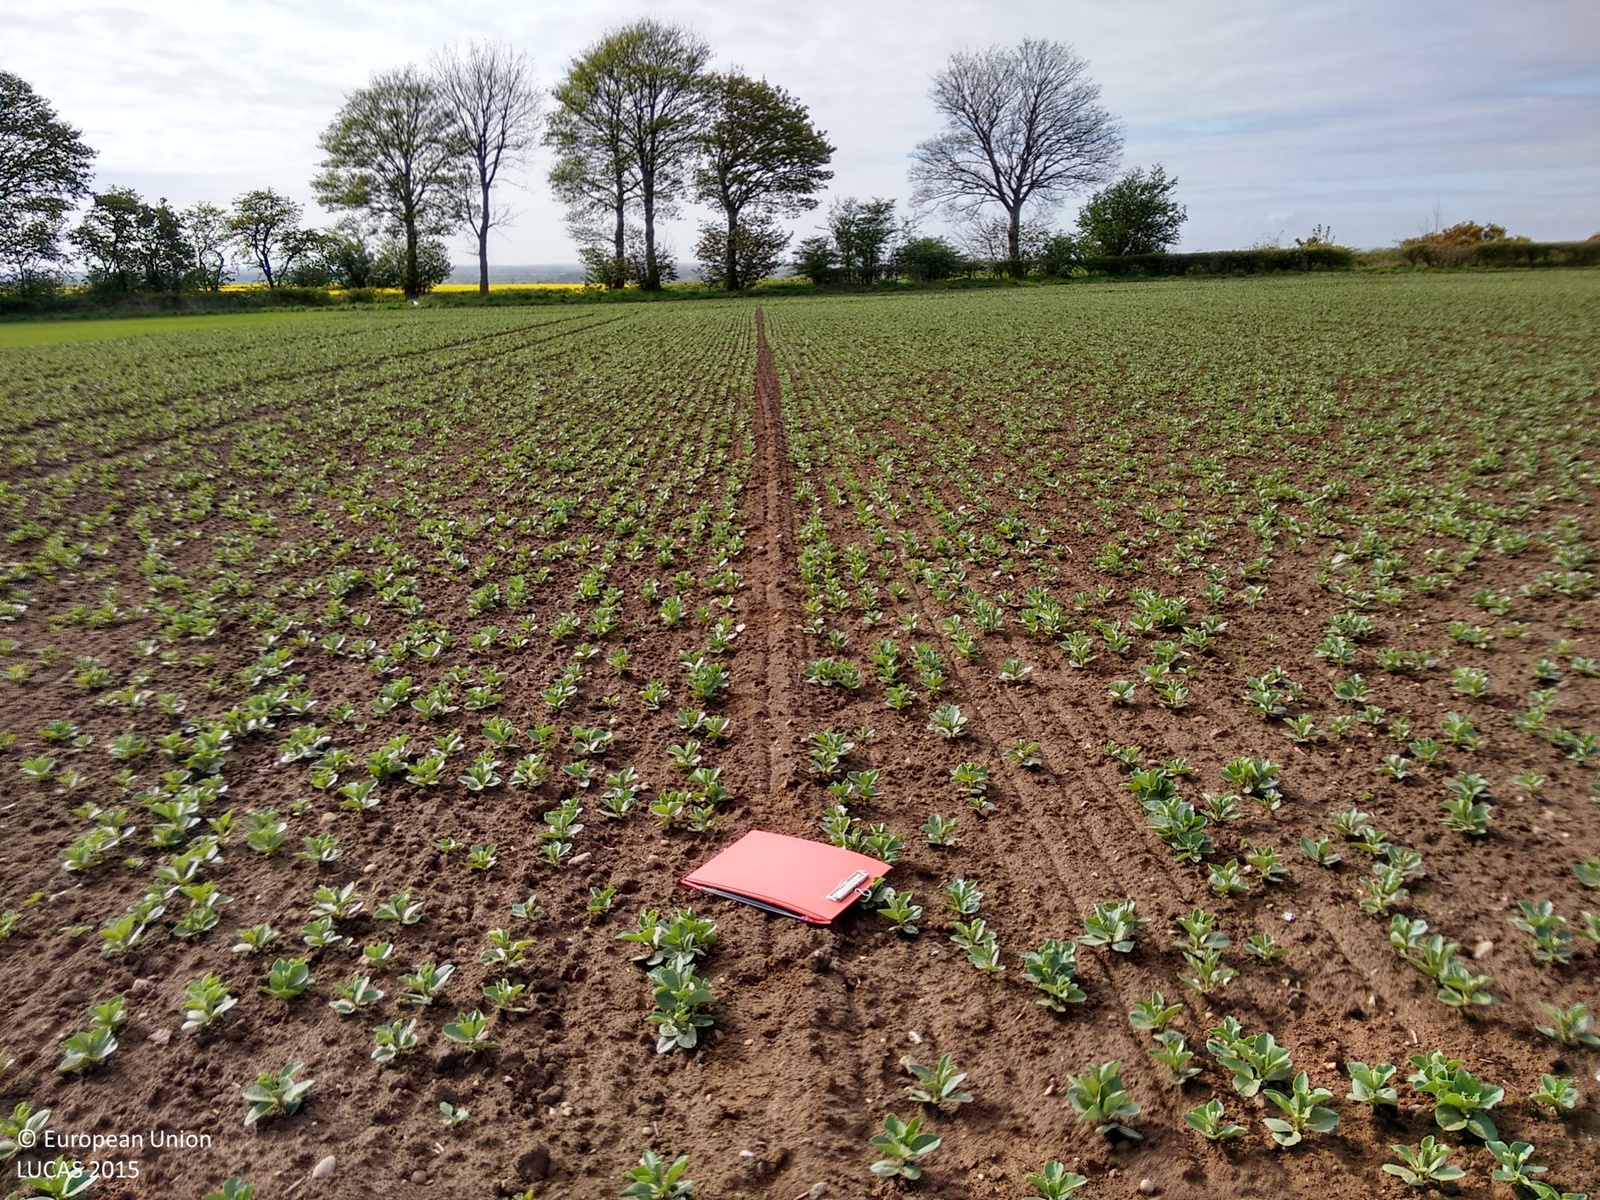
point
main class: Cropland
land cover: Dry pulses
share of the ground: 10 - 25 %
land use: Agriculture (excluding fallow land and kitchen gardens)
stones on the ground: < 10 %
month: May
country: GB
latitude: 54.0635
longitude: -0.3480
